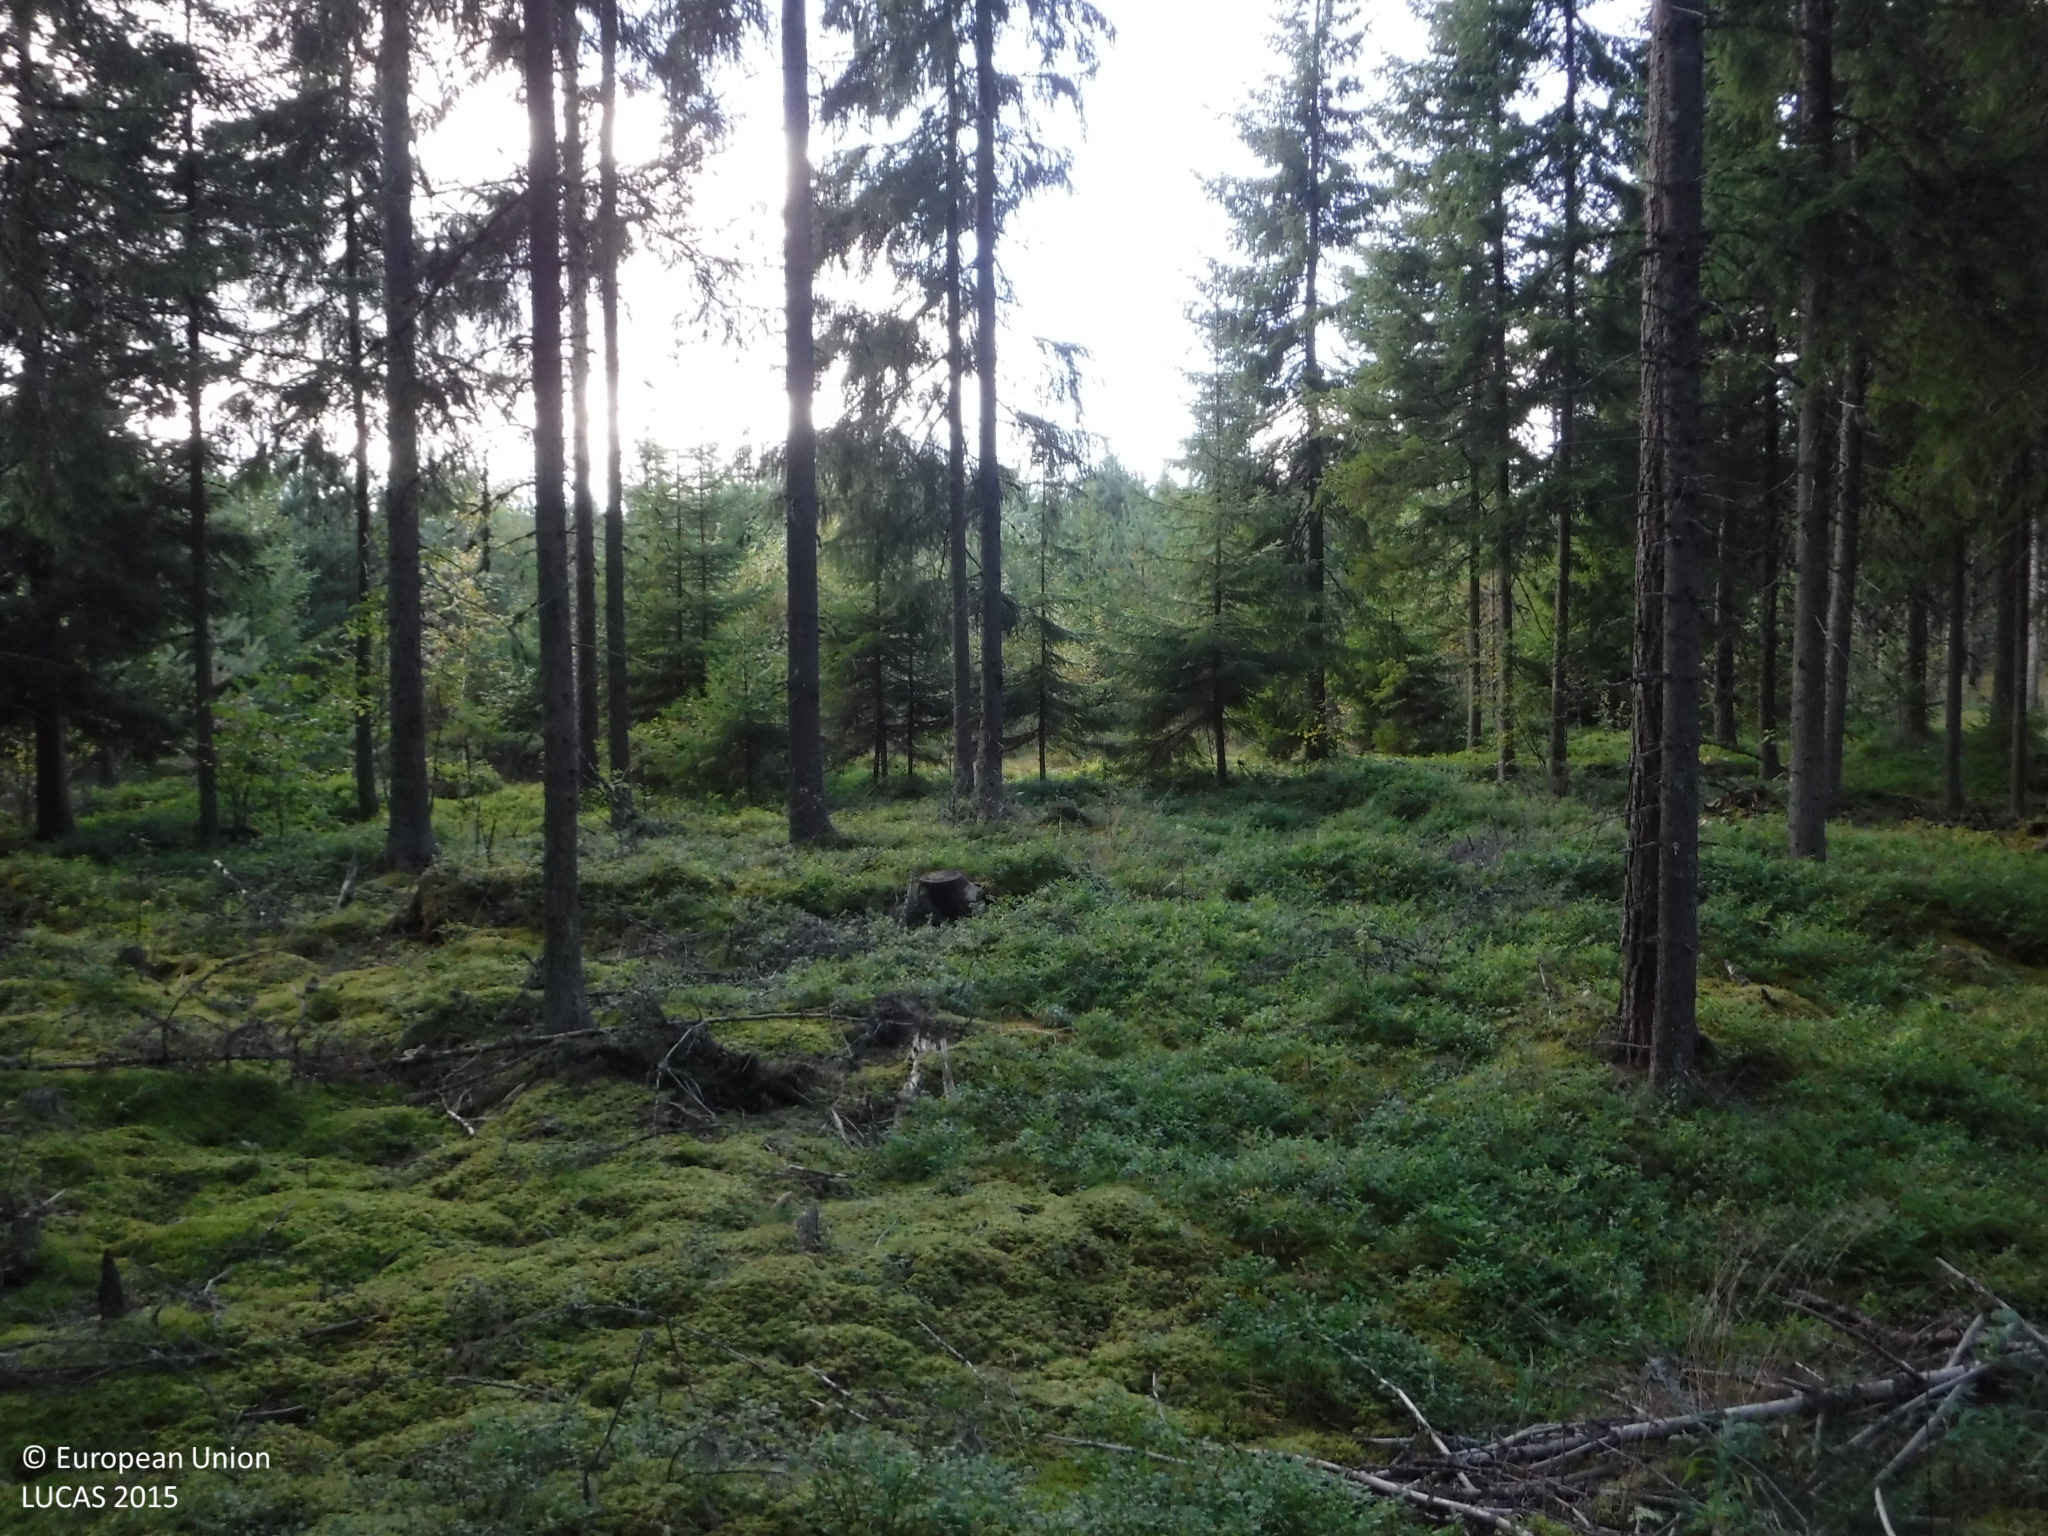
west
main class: Woodland
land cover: Spruce dominated coniferous woodland
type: boreal forest
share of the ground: 50 - 75 %
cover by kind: coniferous forest trees 50 %, shrubs 40 %, lichens and mosses 10 %
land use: Forestry
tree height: > 5 m
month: August
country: FI
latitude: 61.1885
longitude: 21.9064
